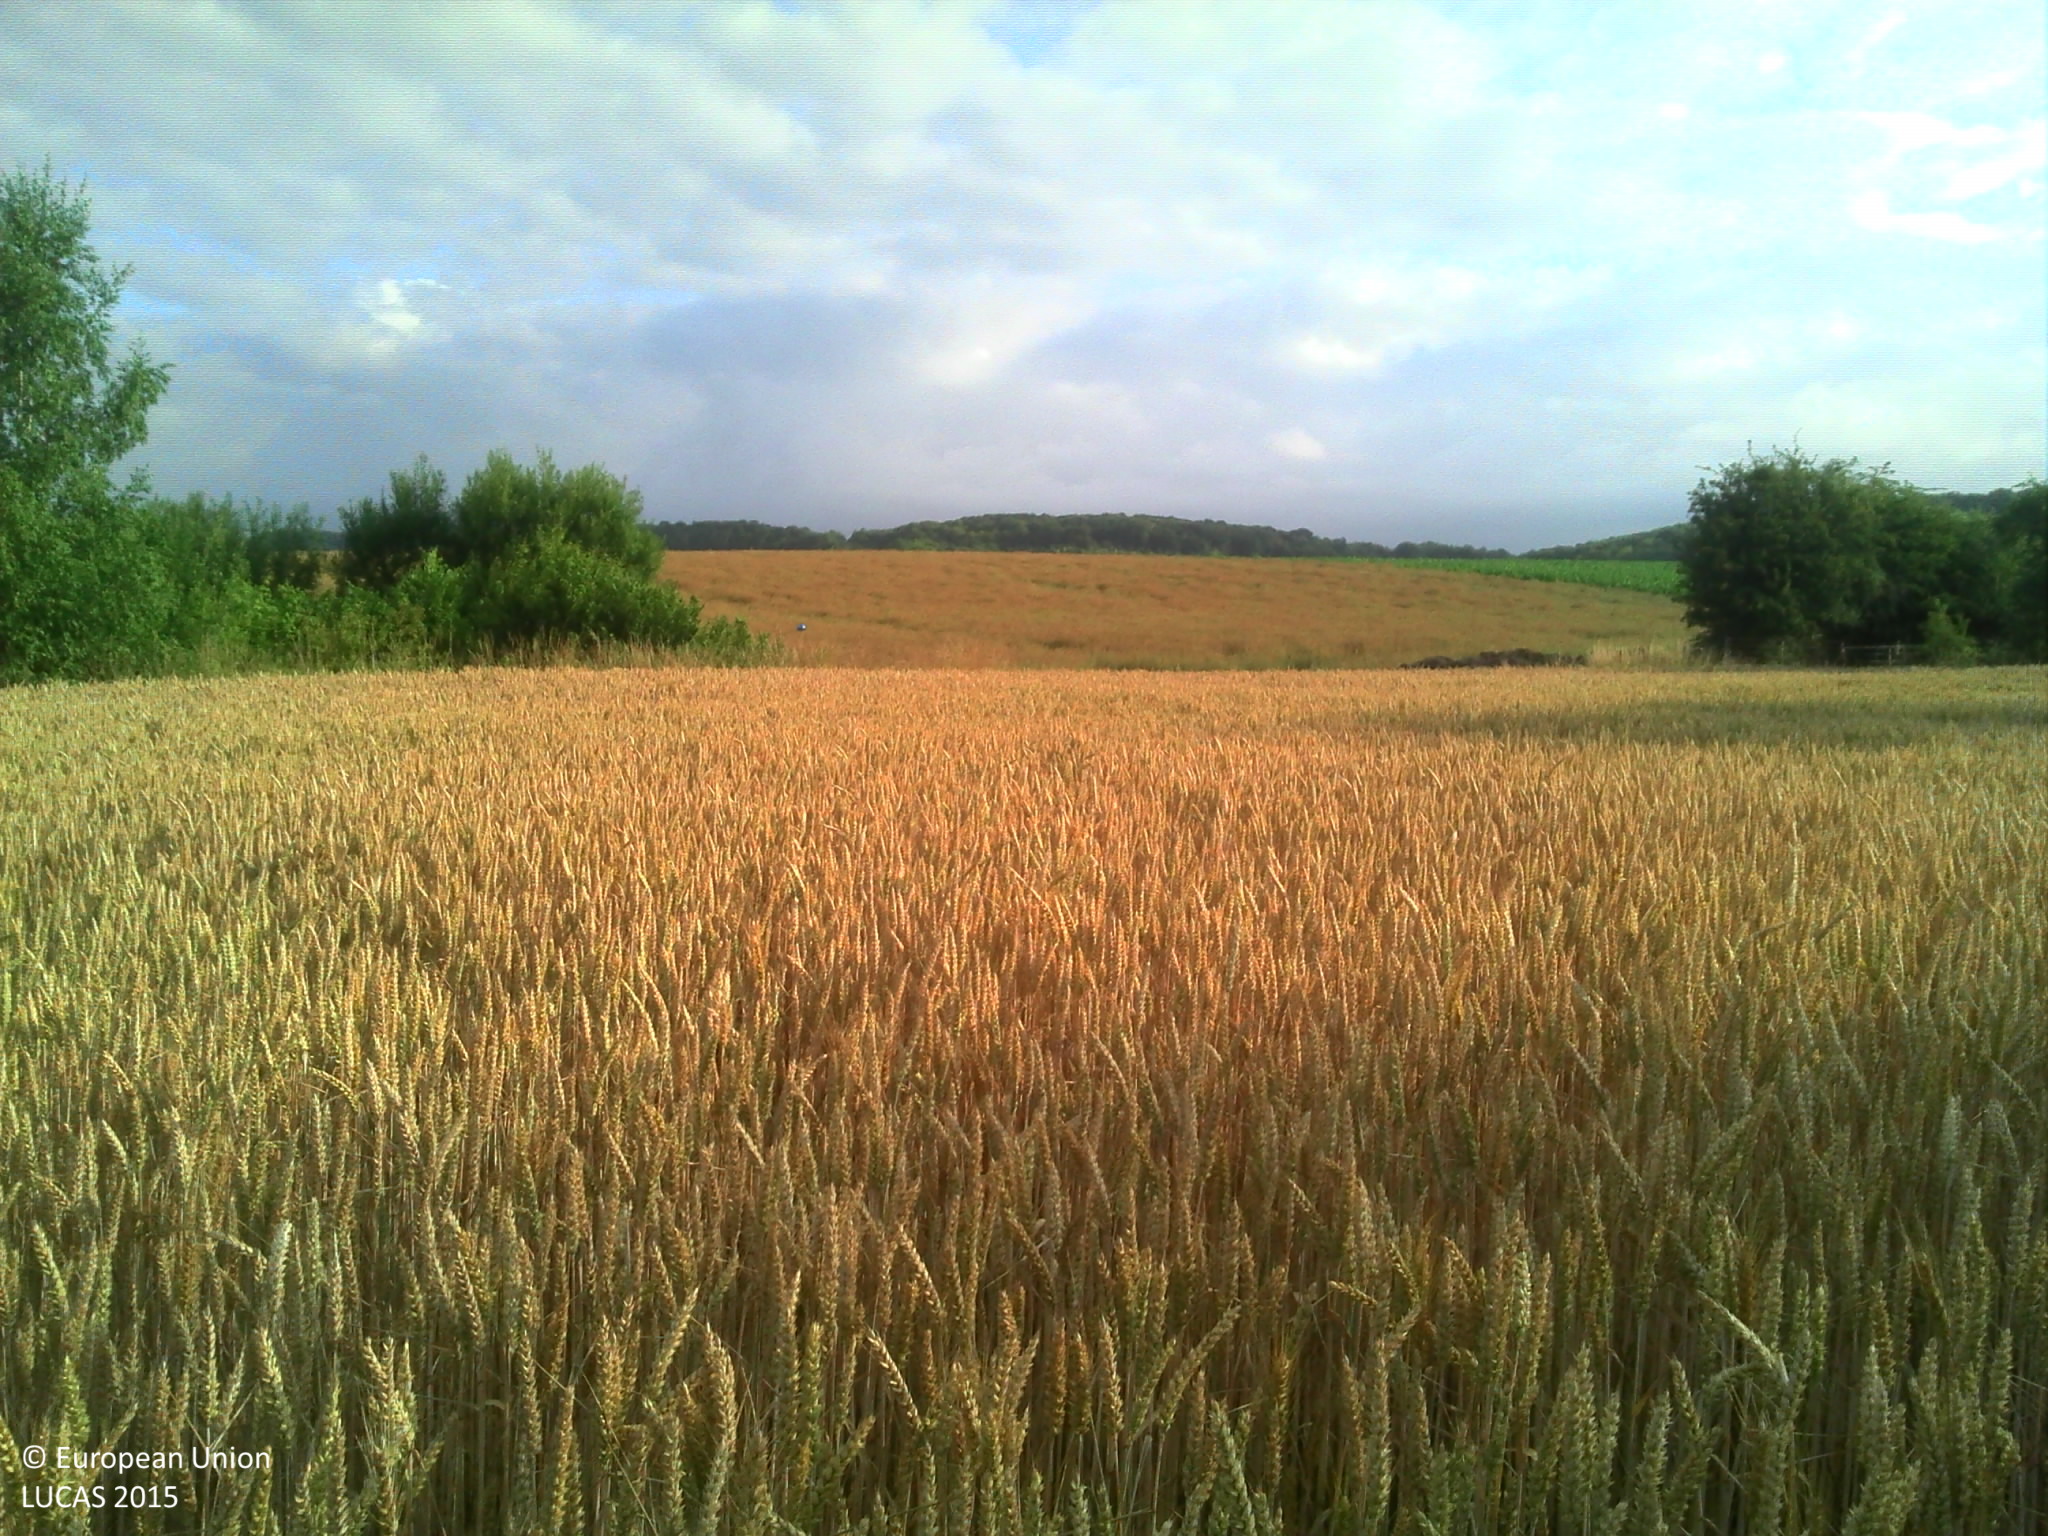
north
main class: Cropland
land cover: Common wheat
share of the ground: > 75 %
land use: Agriculture (excluding fallow land and kitchen gardens)
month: July
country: FR
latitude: 49.8993
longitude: 1.6990
